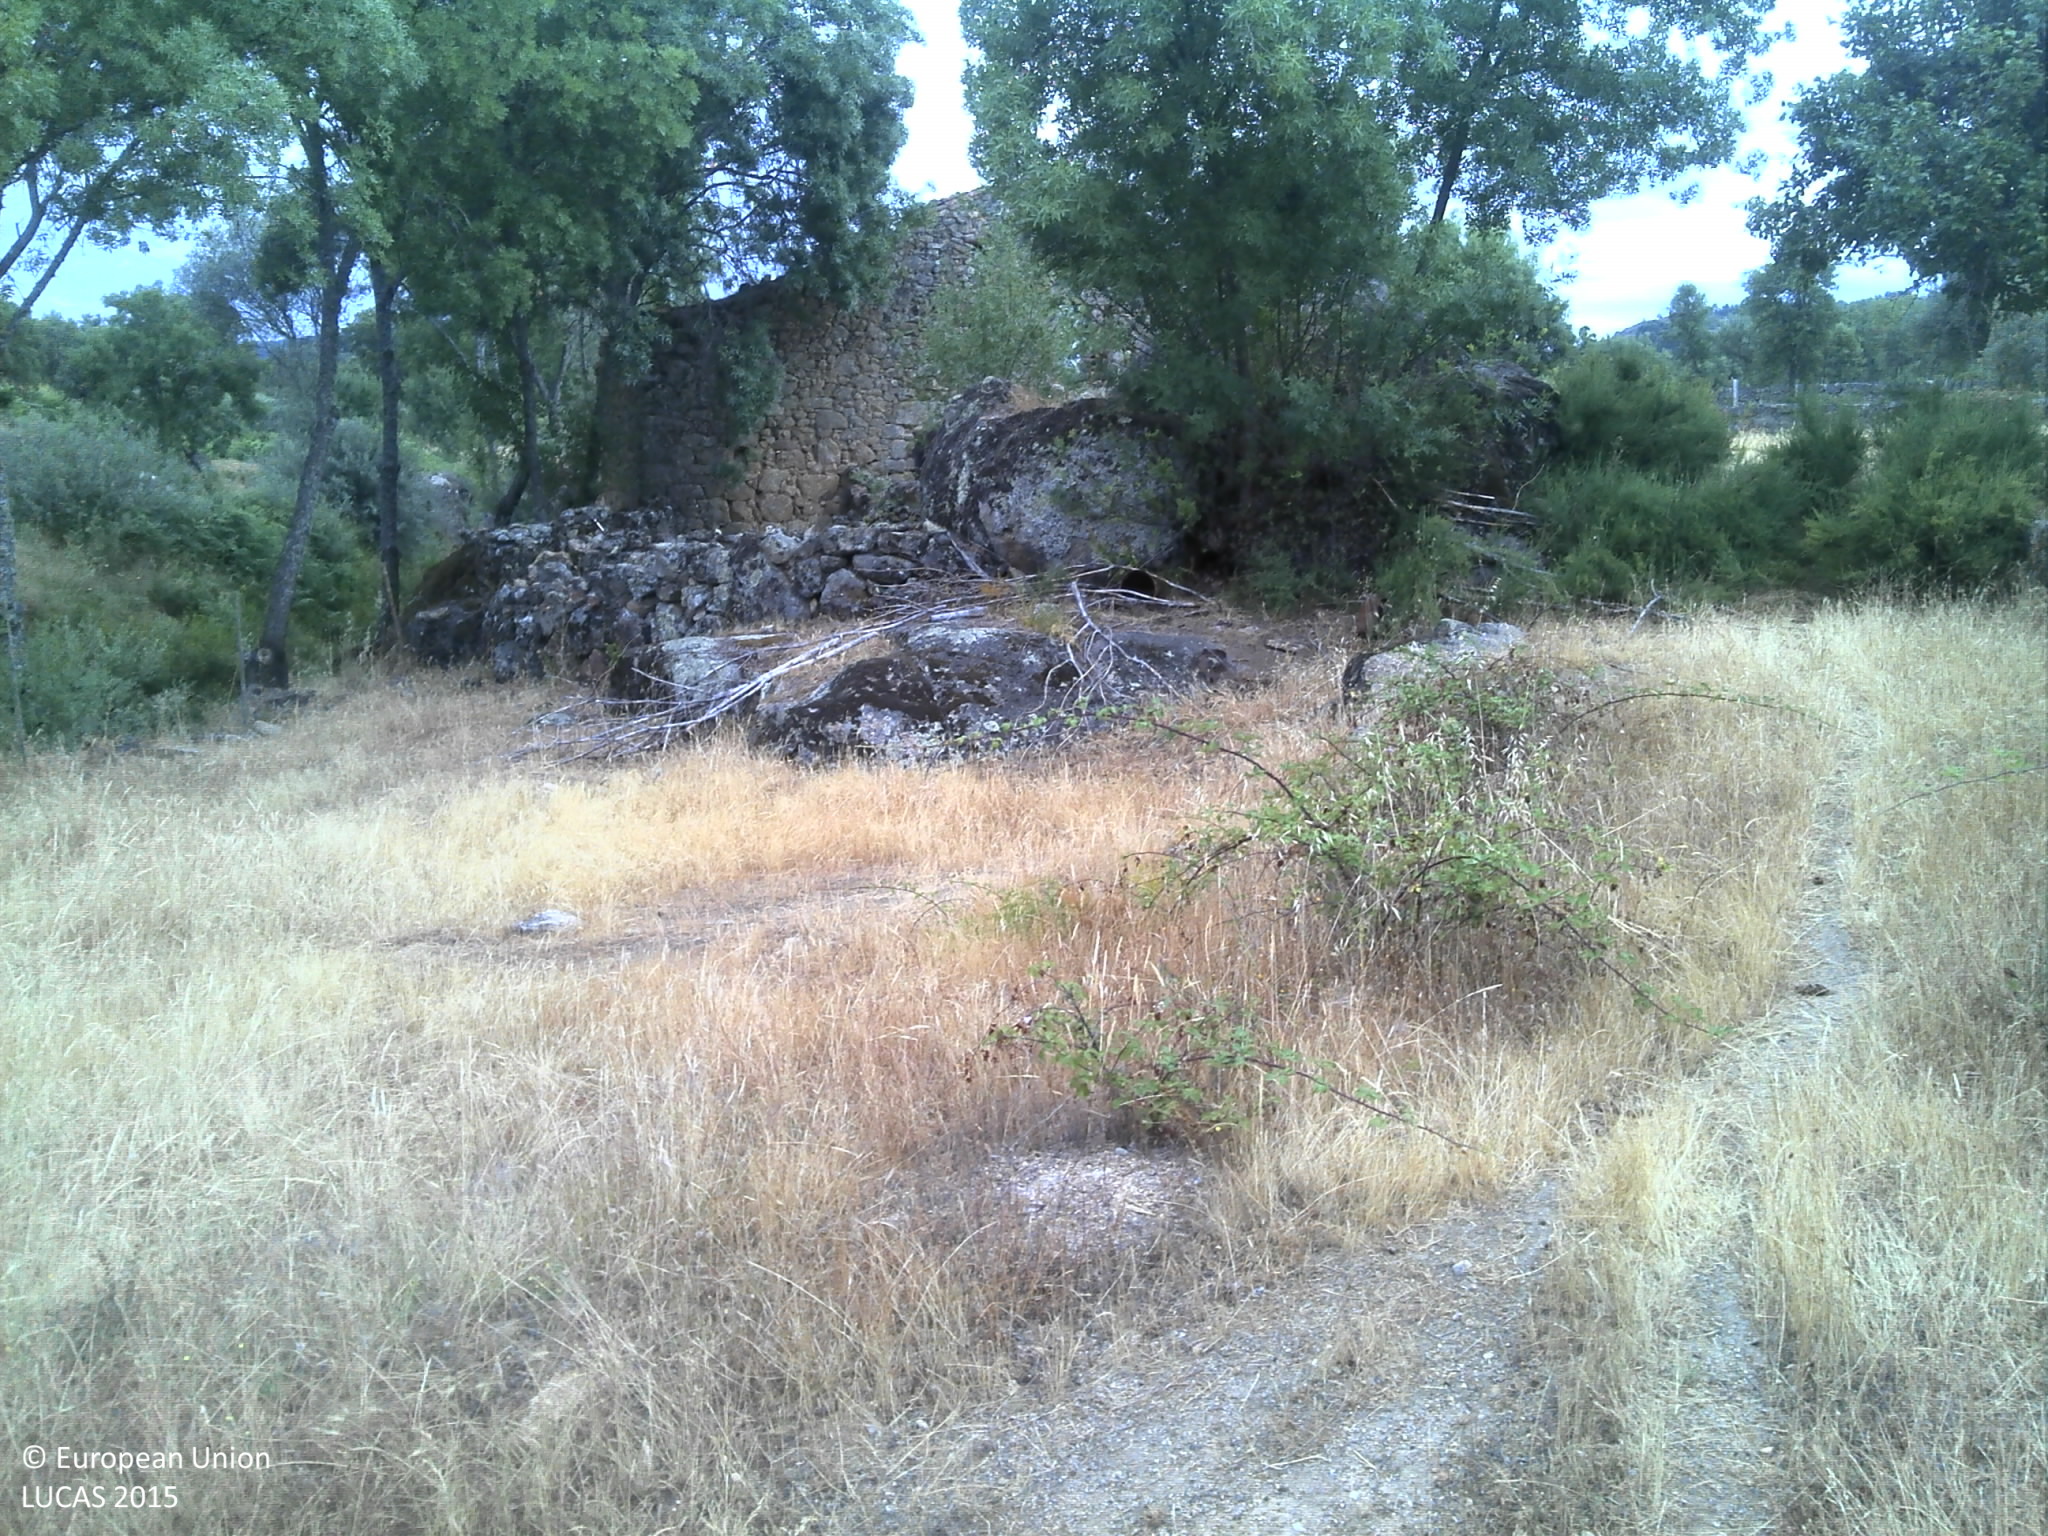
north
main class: Grassland
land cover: Grassland without tree/shrub cover
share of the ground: 50 - 75 %
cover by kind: herbaceous plants 60 %, unconsolidated bare surface 40 %
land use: Agriculture (excluding fallow land and kitchen gardens)
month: June
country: PT
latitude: 40.1553
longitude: -7.2029
